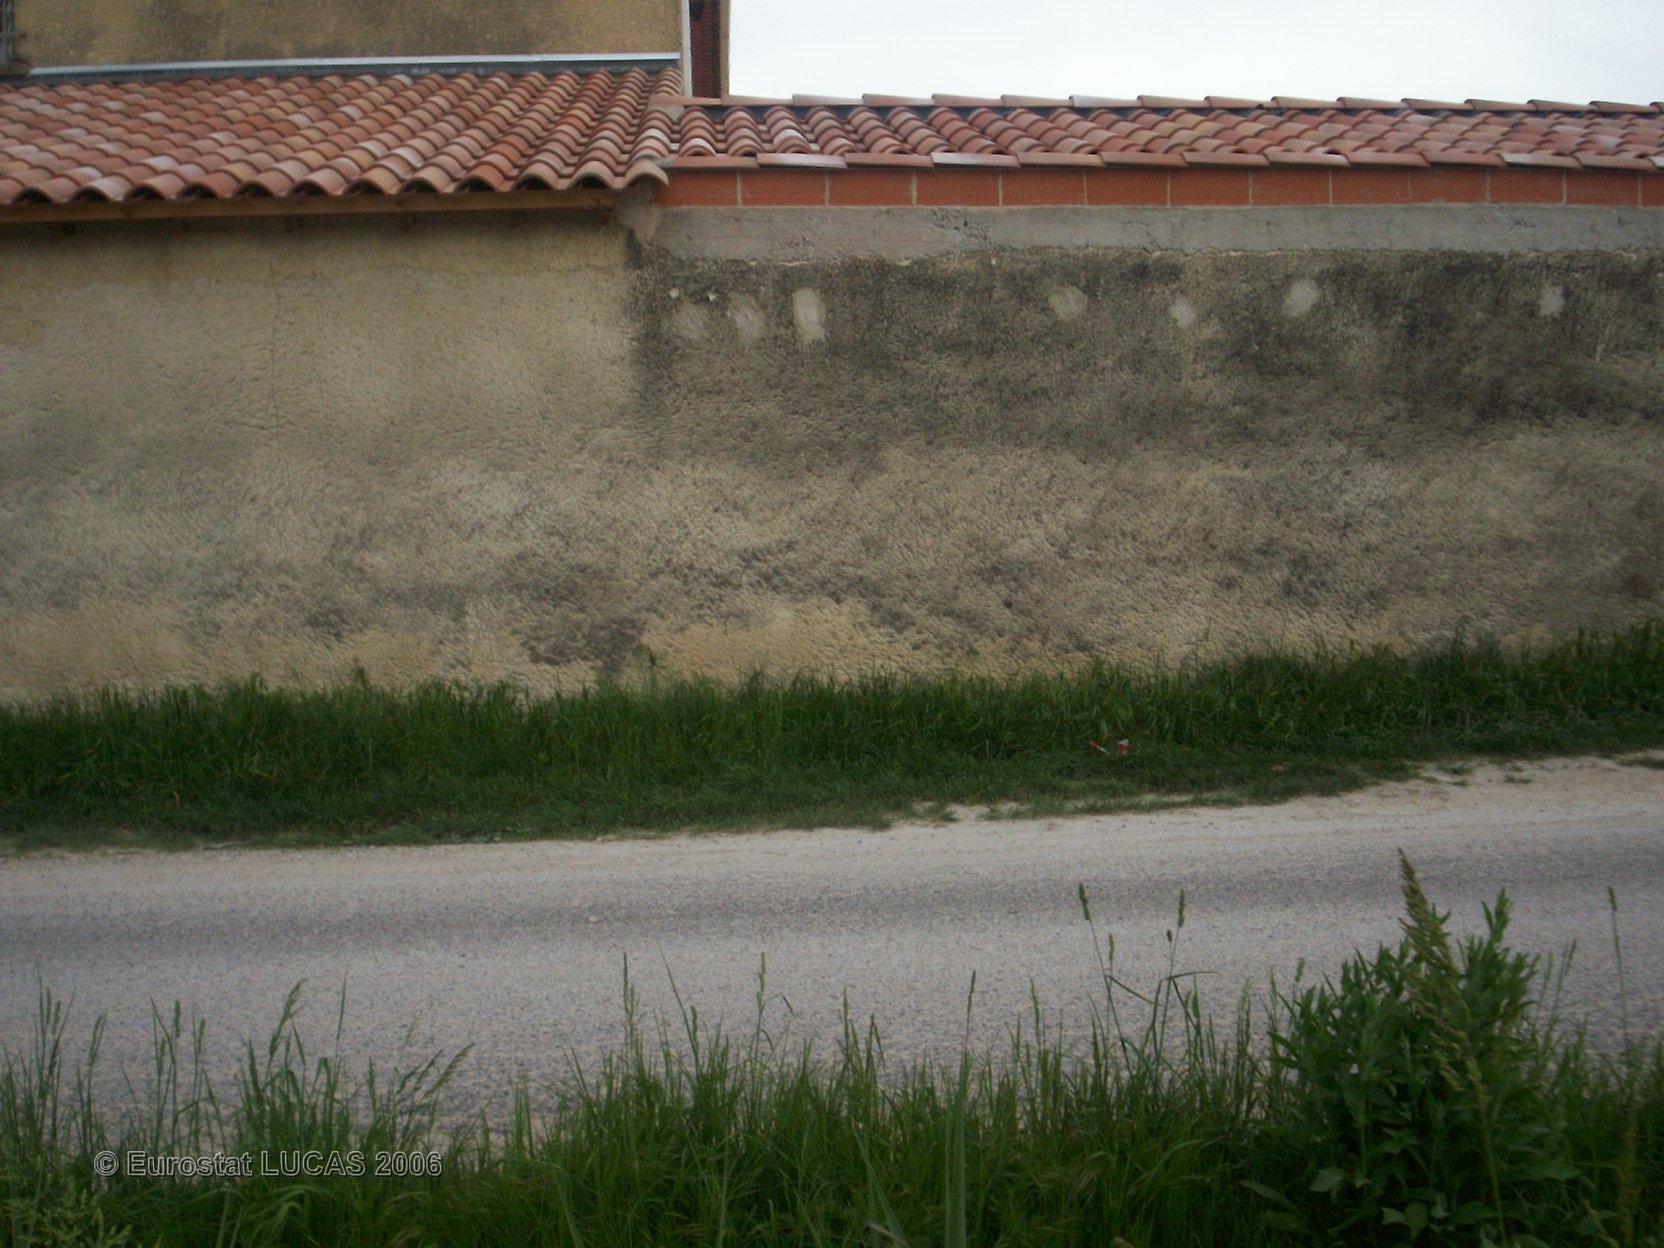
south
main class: Grassland
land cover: Grassland without tree/shrub cover
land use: Agriculture (excluding fallow land and kitchen gardens)
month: April
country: FR
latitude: 44.0483
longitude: 4.9784
